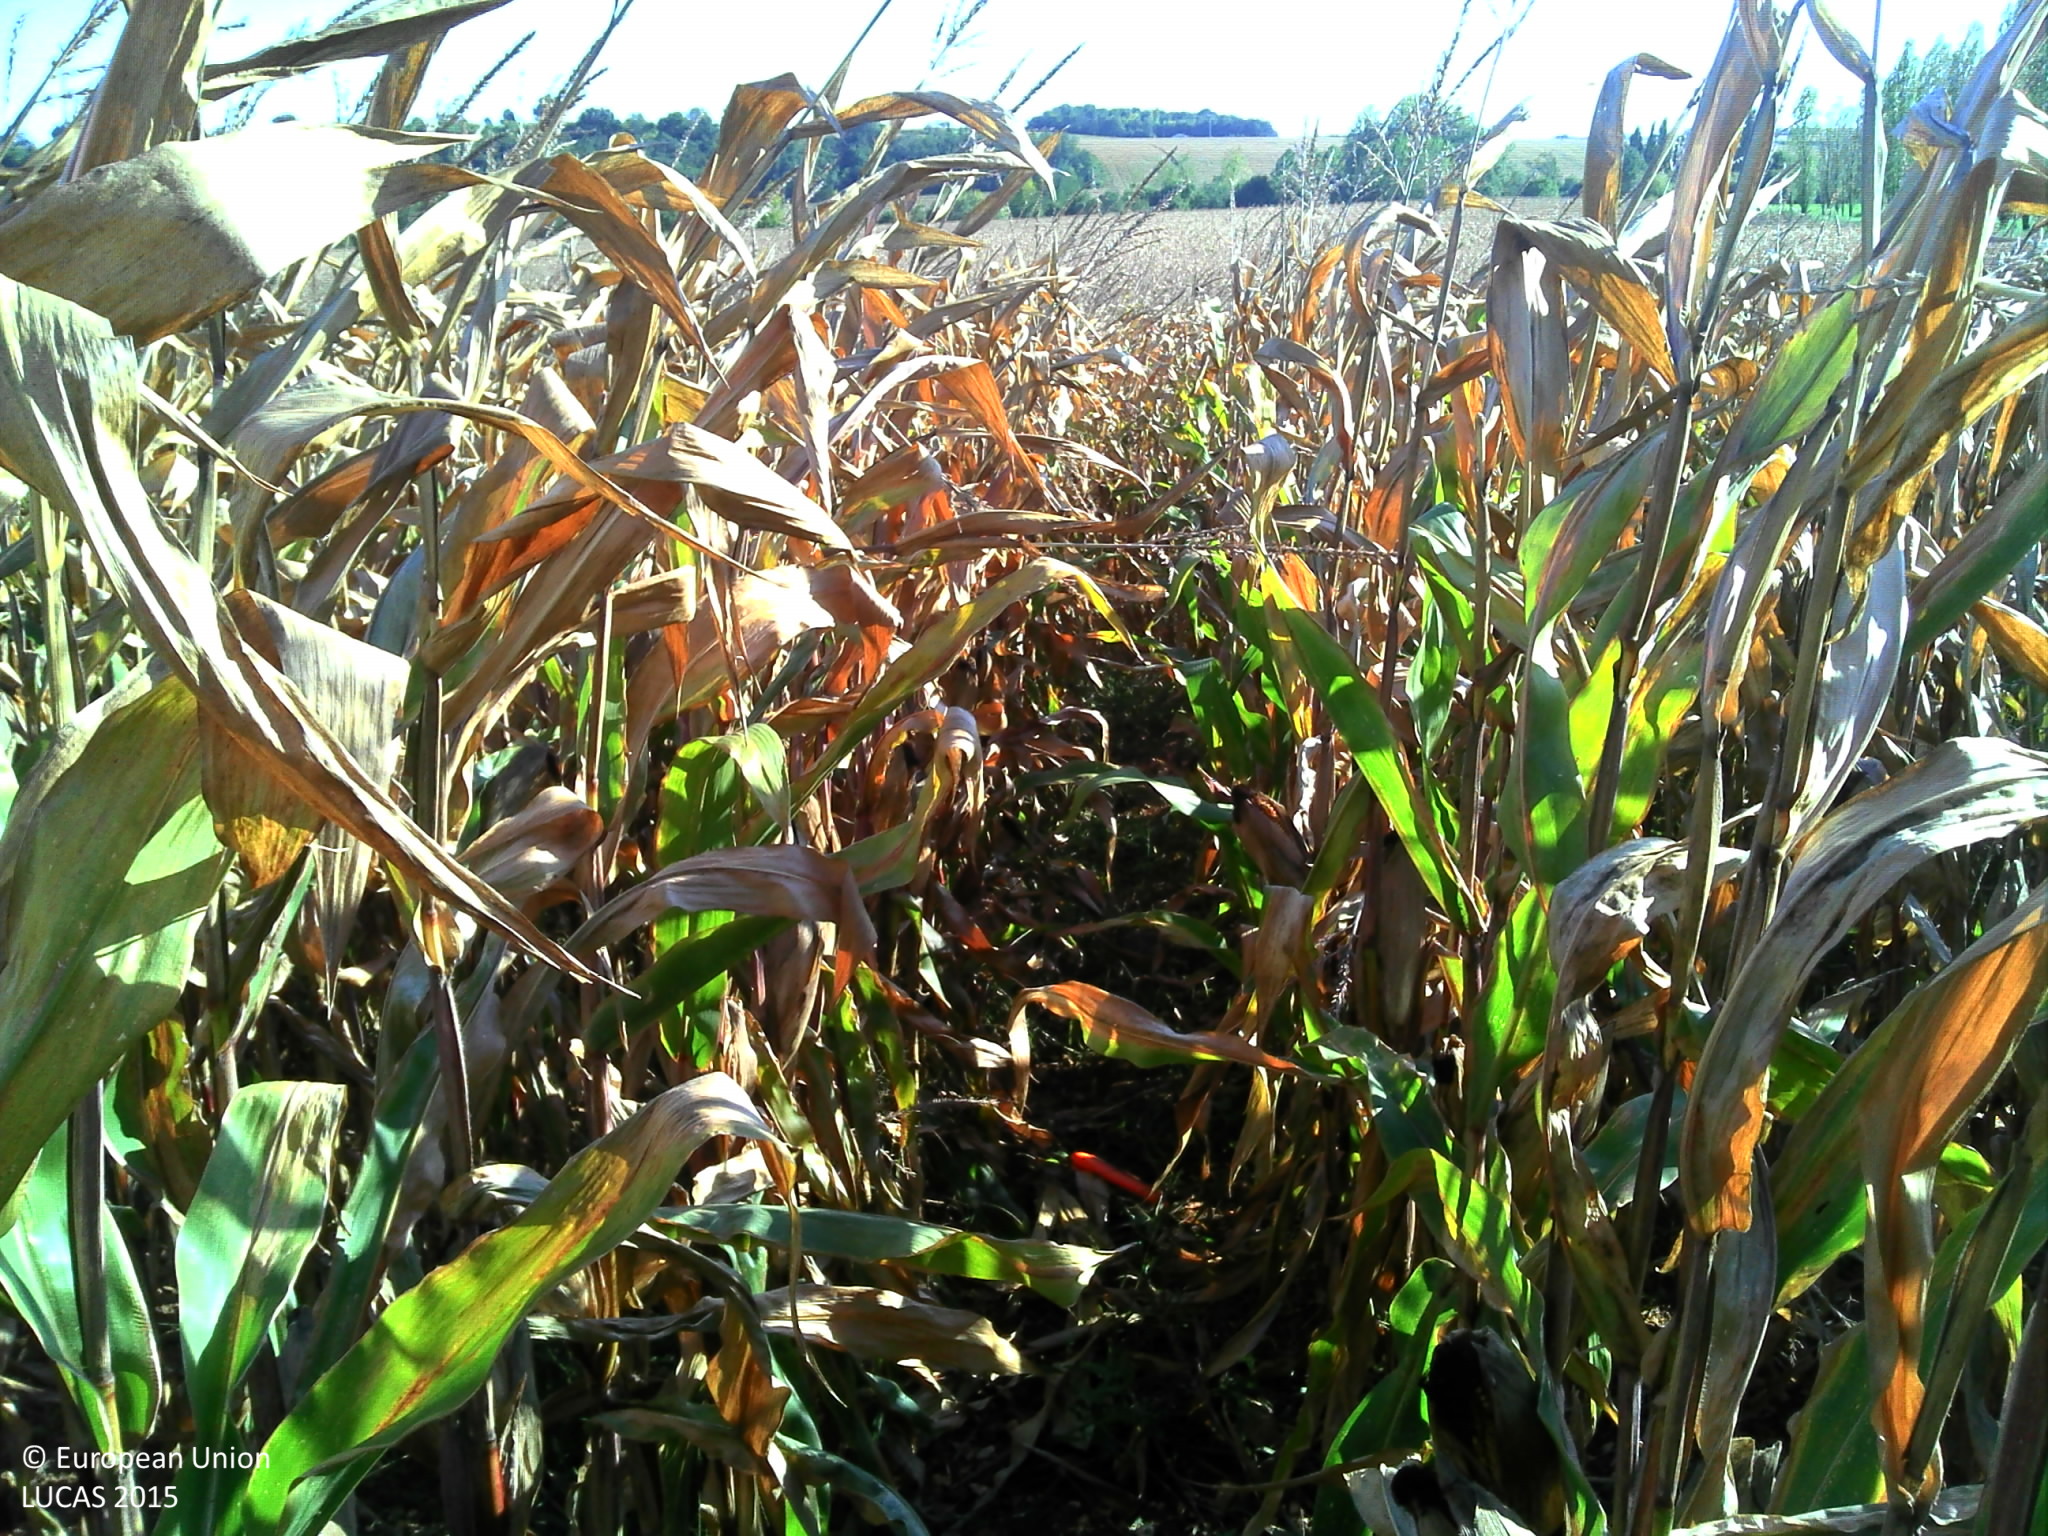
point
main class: Cropland
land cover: Maize
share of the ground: 50 - 75 %
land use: Agriculture (excluding fallow land and kitchen gardens)
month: September
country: FR
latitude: 46.5674
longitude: -1.1362
